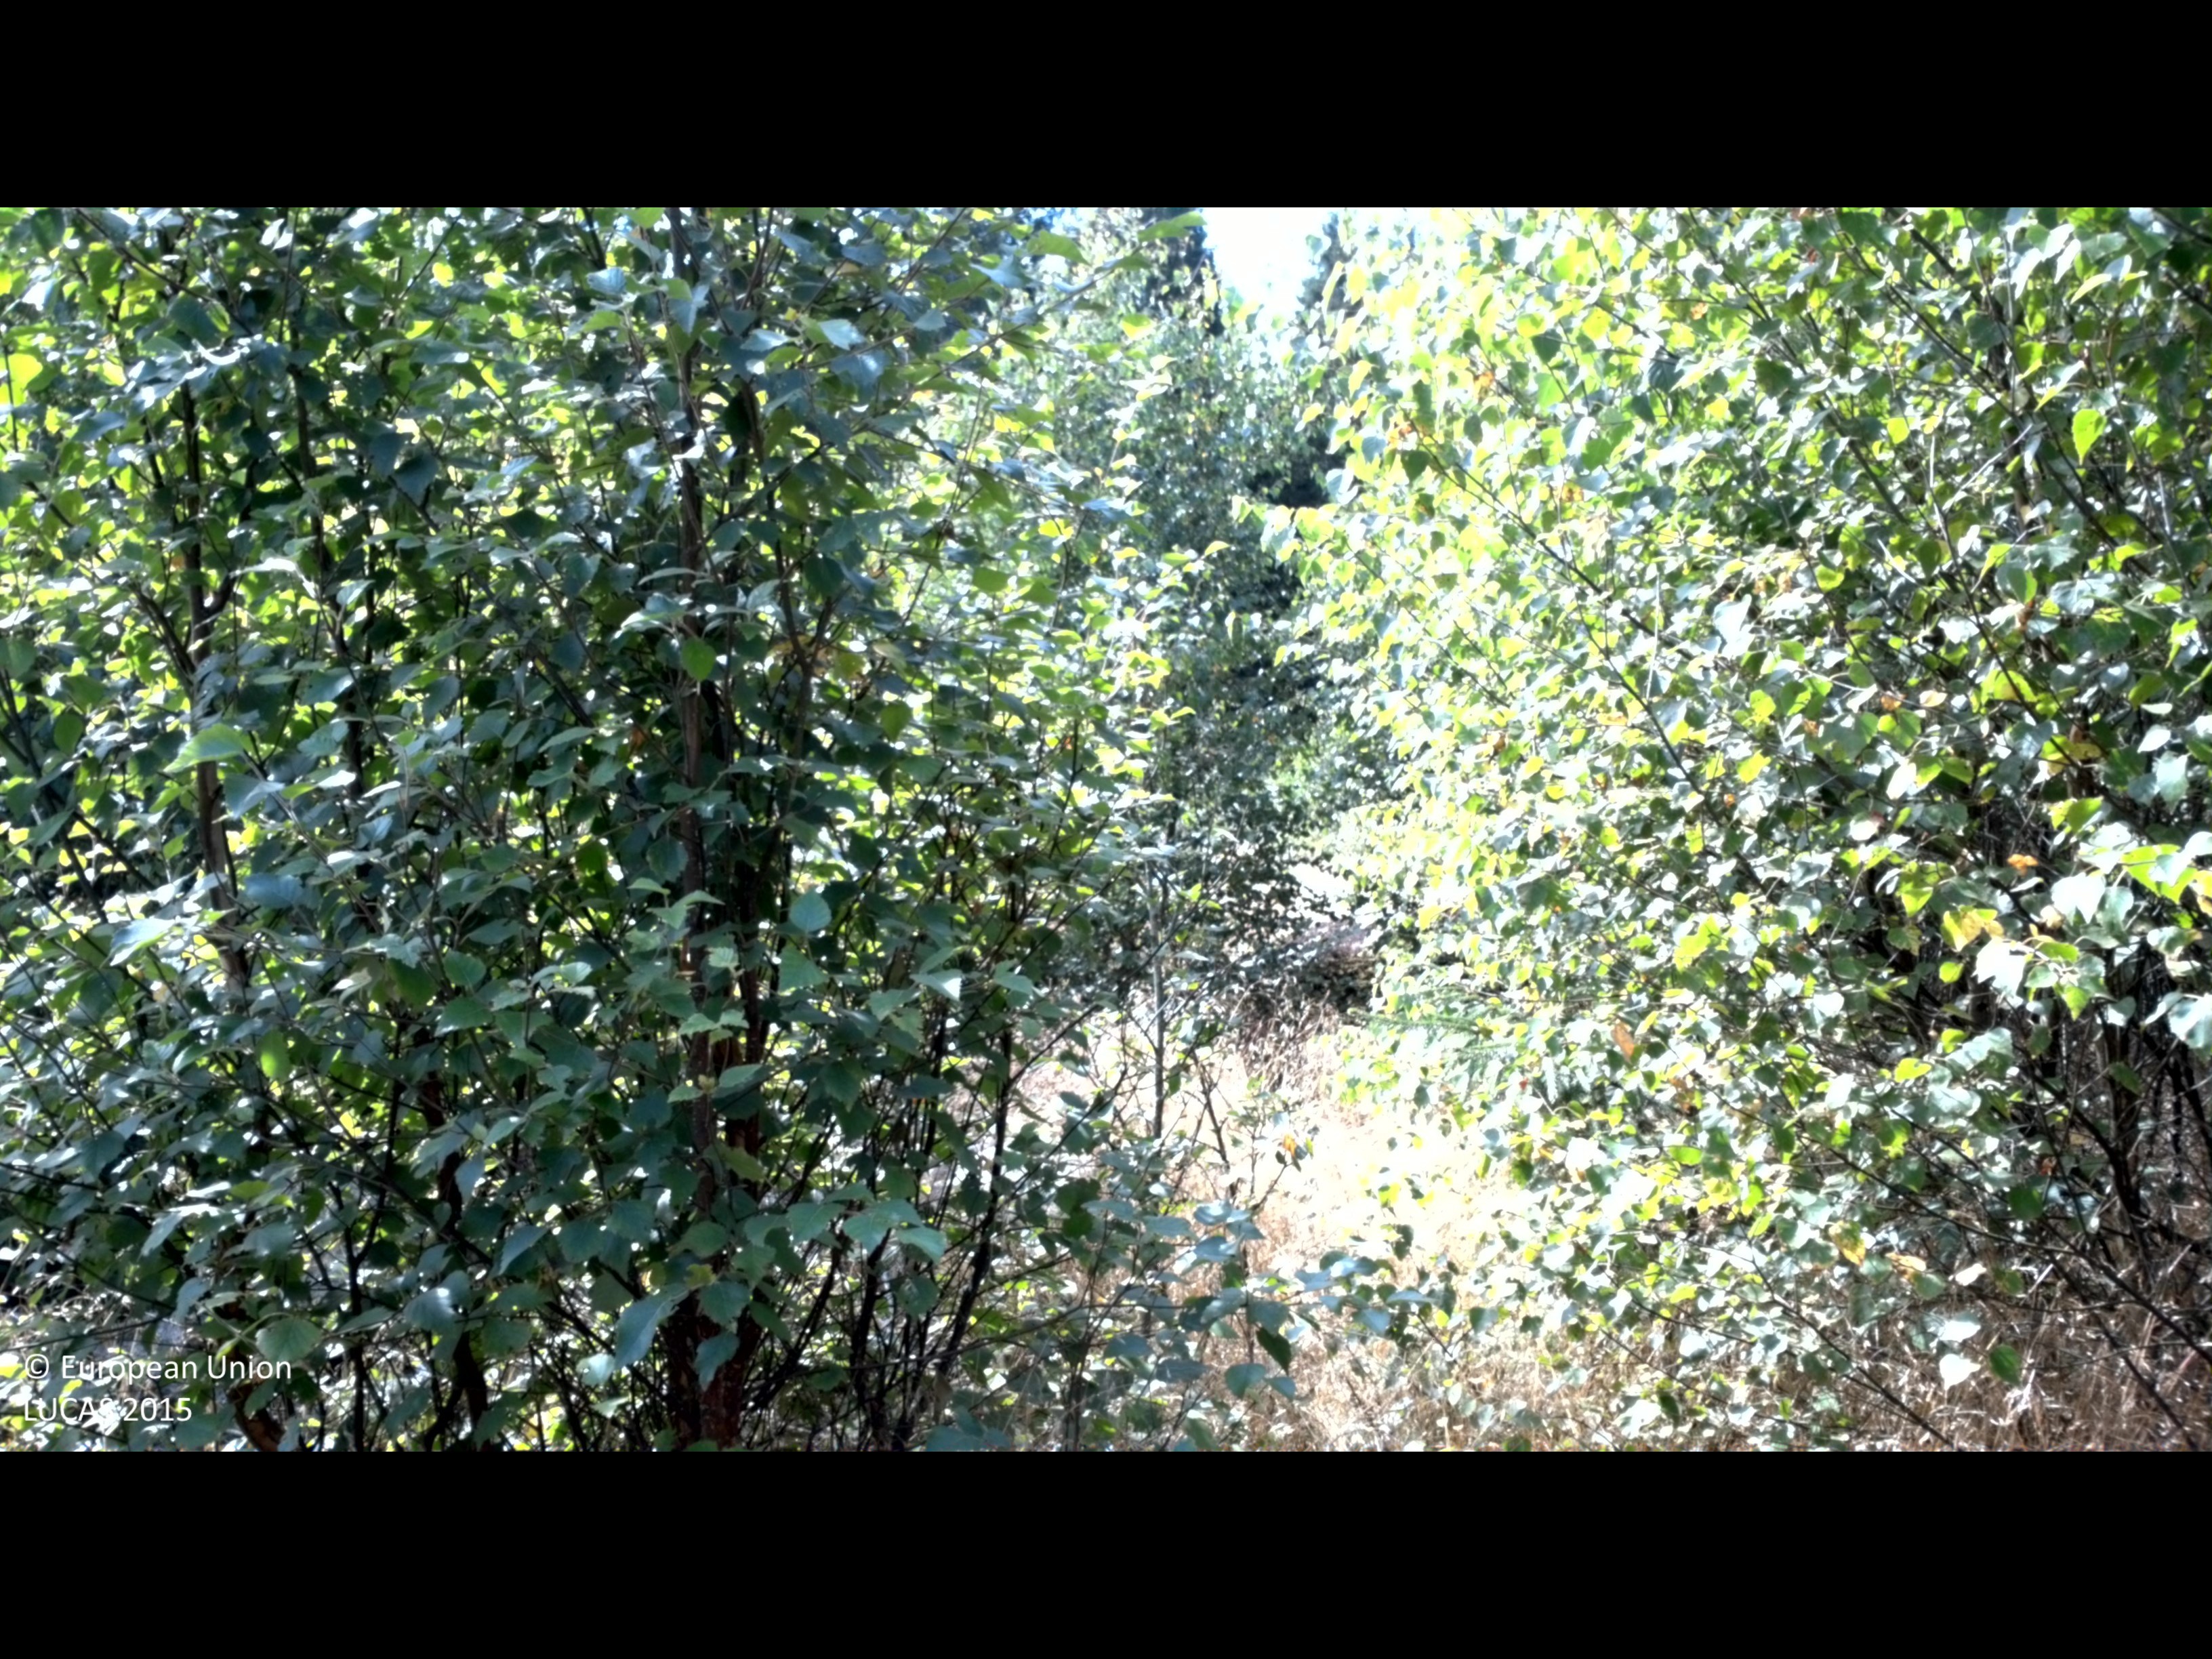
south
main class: Woodland
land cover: Broadleaved woodland
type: boreal forest
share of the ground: 50 - 75 %
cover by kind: broadleaved forest trees 65 %, herbaceous plants 25 %, coniferous forest trees 5 %, shrubs 5 %
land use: Forestry
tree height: < 5 m
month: August
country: SE
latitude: 56.2702
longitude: 15.8620
